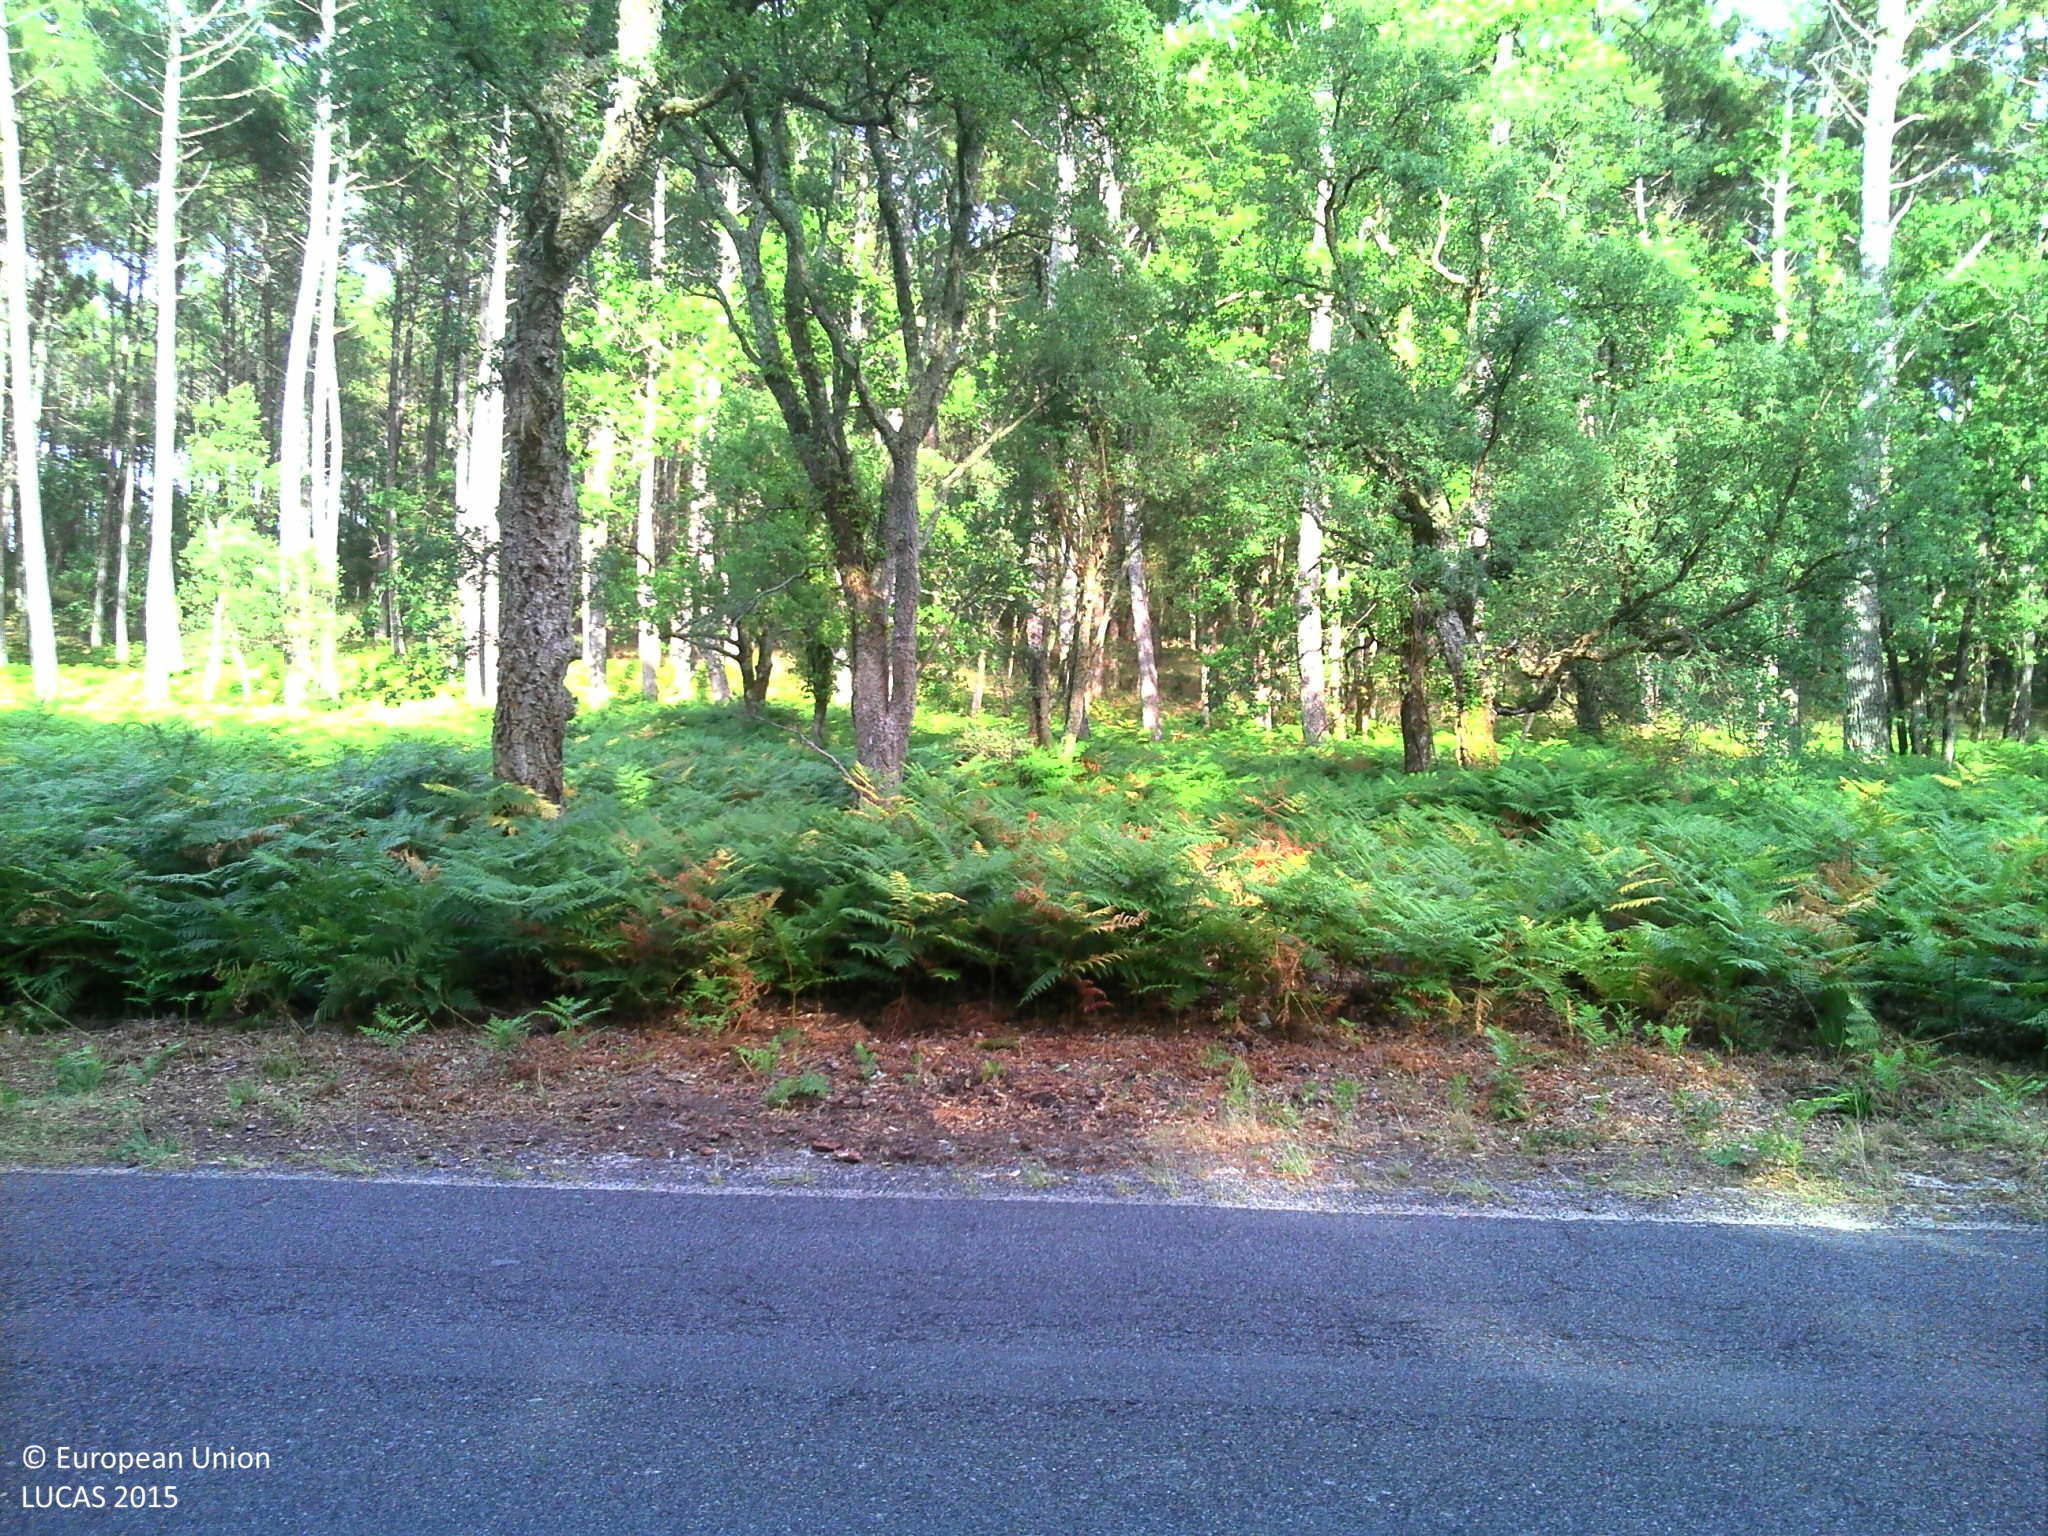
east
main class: Woodland
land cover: Pine dominated mixed woodland
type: coniferous forest of the mediterranean region
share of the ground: > 75 %
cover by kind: coniferous forest trees 50 %, broadleaved forest trees 25 %, herbaceous plants 15 %, unconsolidated bare surface 10 %
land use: Residential
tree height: > 5 m
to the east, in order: Pine dominated mixed woodland; Artificial constructions in urban areas; Pine dominated coniferous woodland; Paved roads, cycling and walking lanes; Pine dominated coniferous woodland
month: July
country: FR
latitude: 43.9062
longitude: -1.3633
